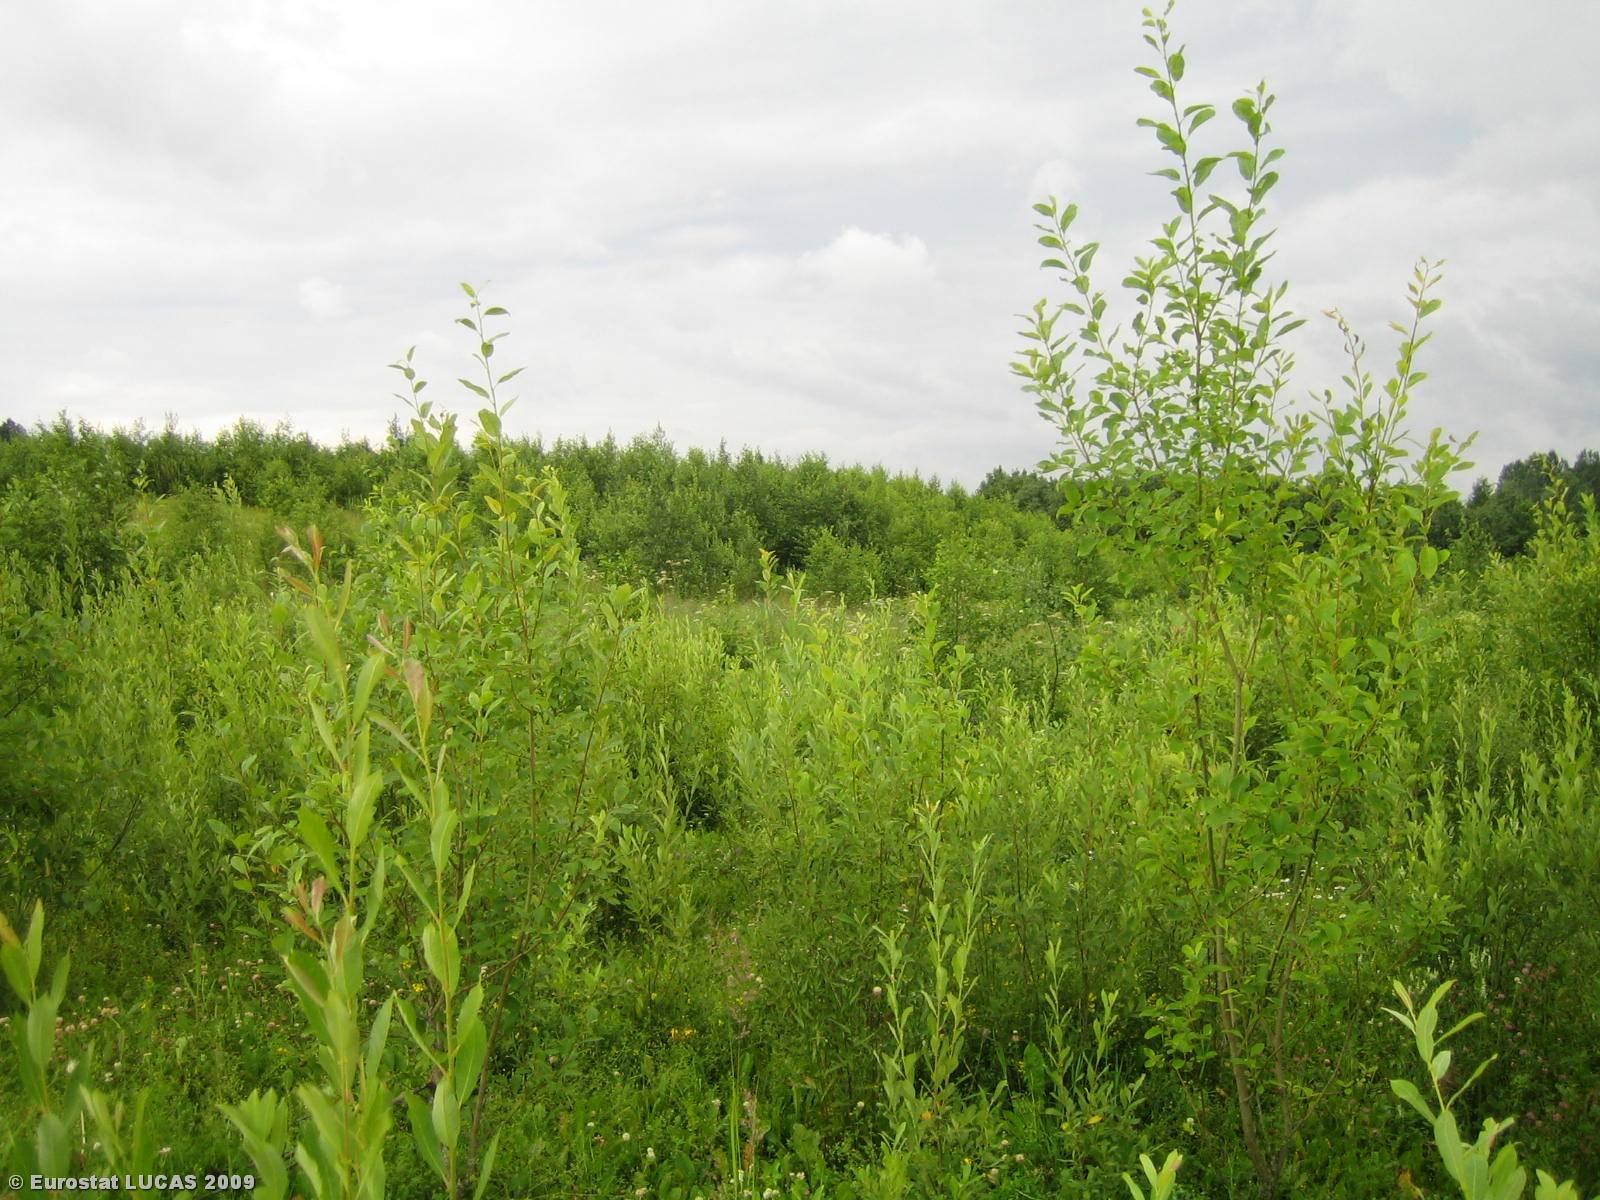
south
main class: Grassland
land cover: Grassland with sparse tree/shrub cover
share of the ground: > 75 %
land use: Agriculture (excluding fallow land and kitchen gardens)
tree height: < 5 m
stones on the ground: < 10 %
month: July
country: LT
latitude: 55.4097
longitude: 25.5899
